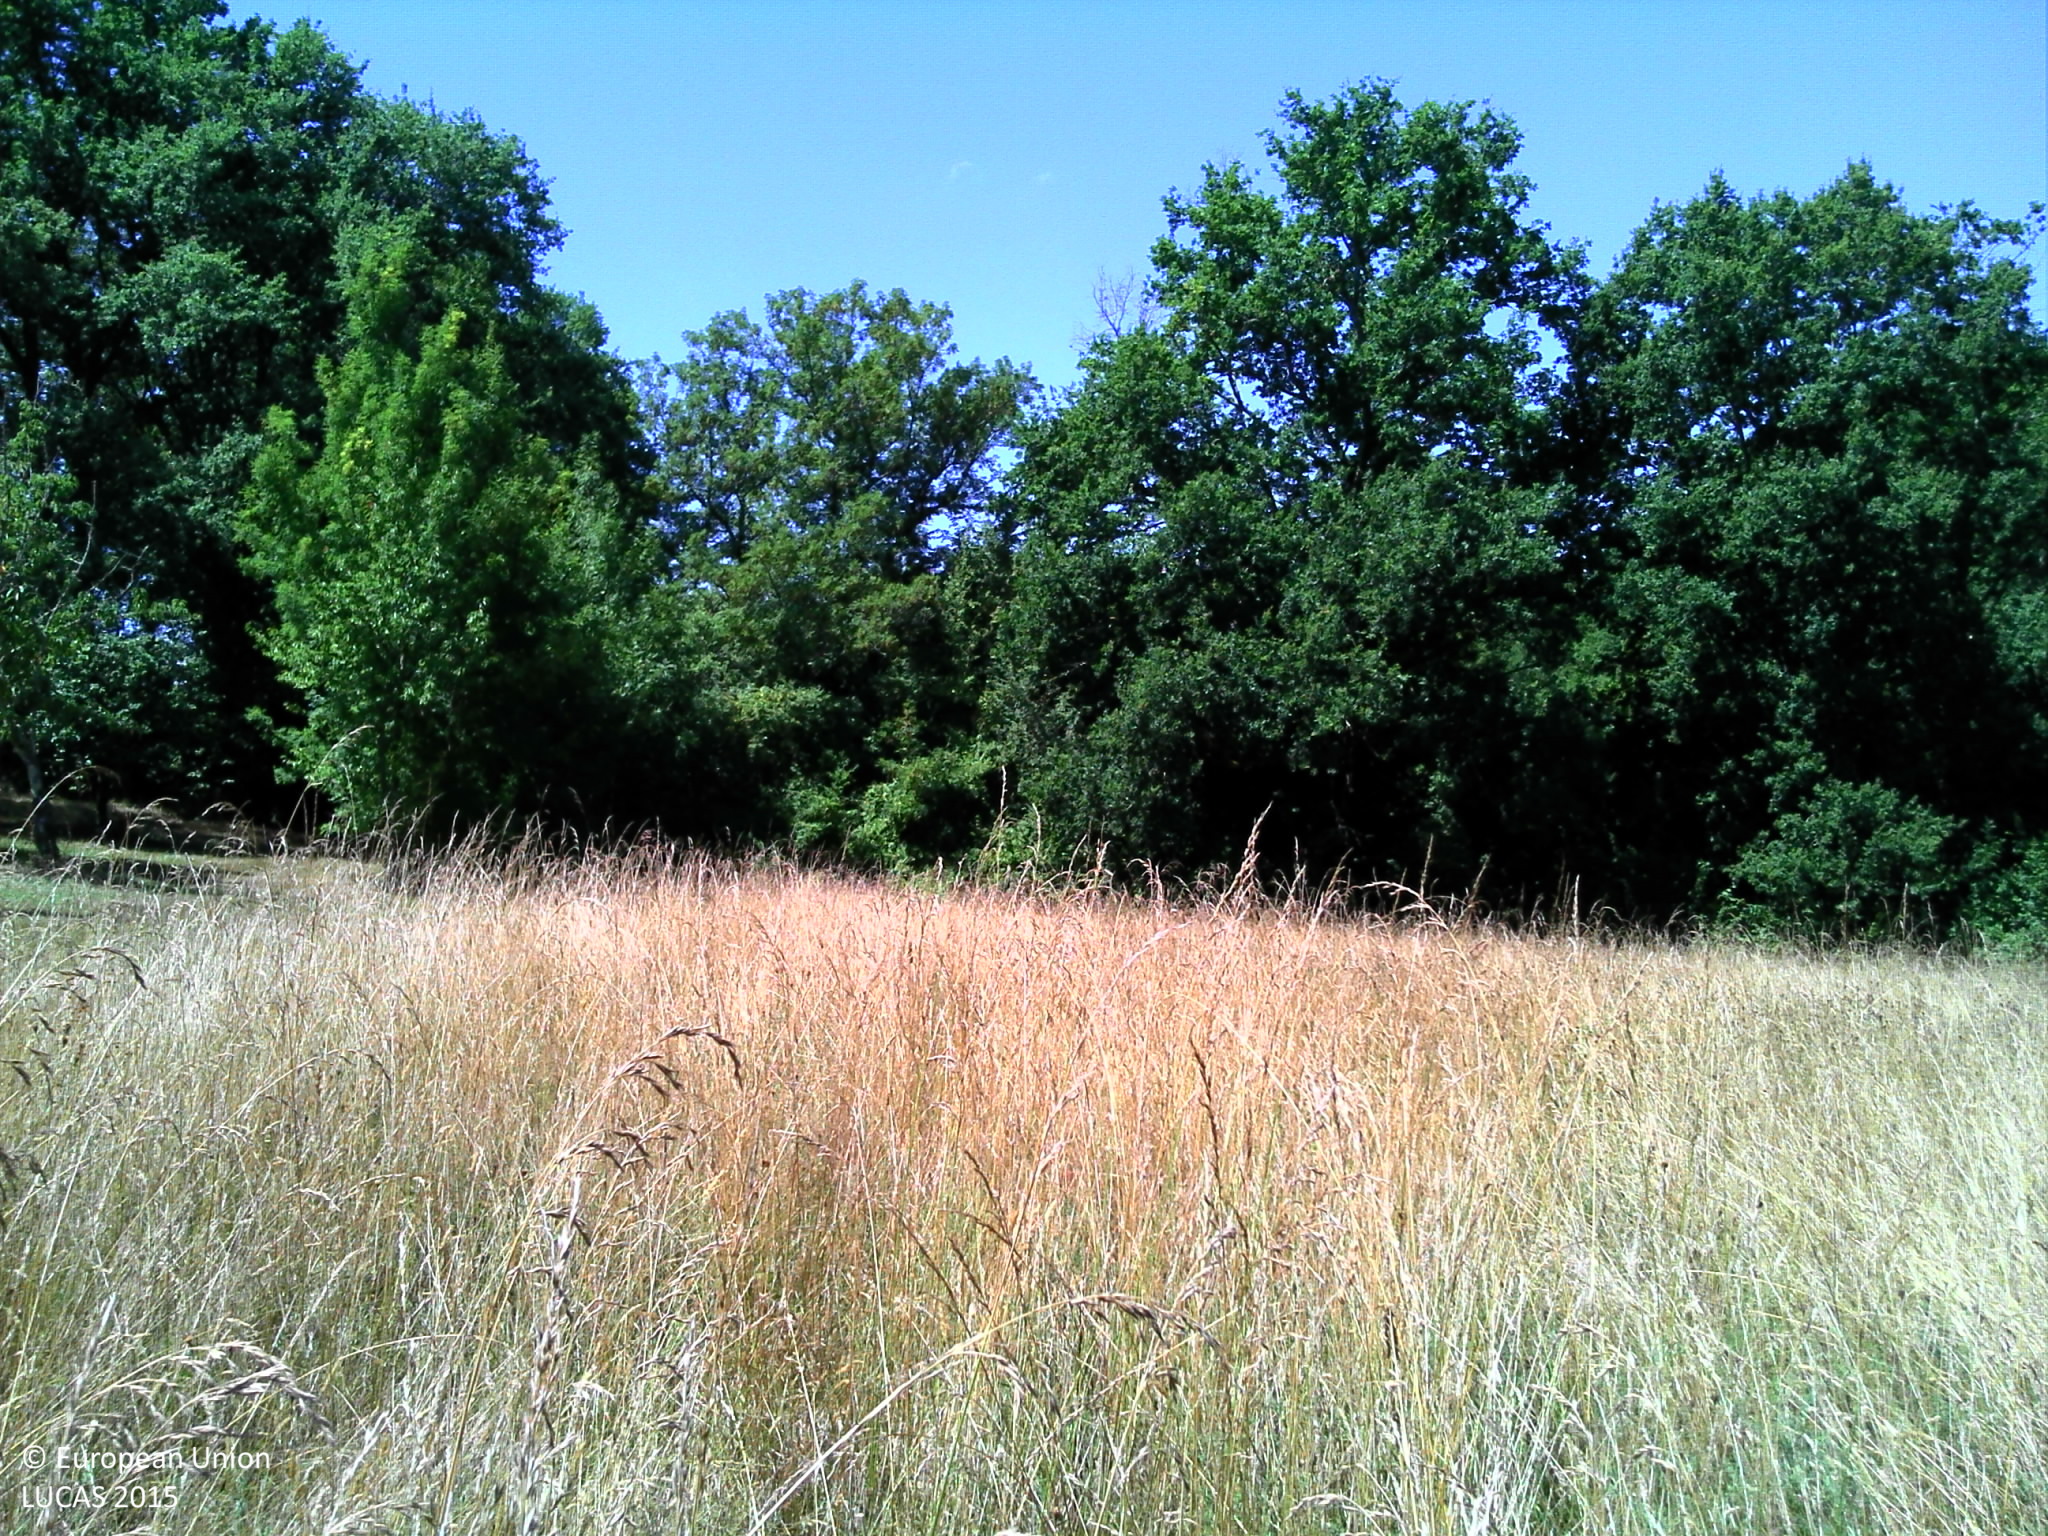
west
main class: Grassland
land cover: Grassland without tree/shrub cover
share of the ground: > 75 %
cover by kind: herbaceous plants 100 %
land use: Agriculture (excluding fallow land and kitchen gardens)
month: July
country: FR
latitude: 44.8810
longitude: 0.5591
